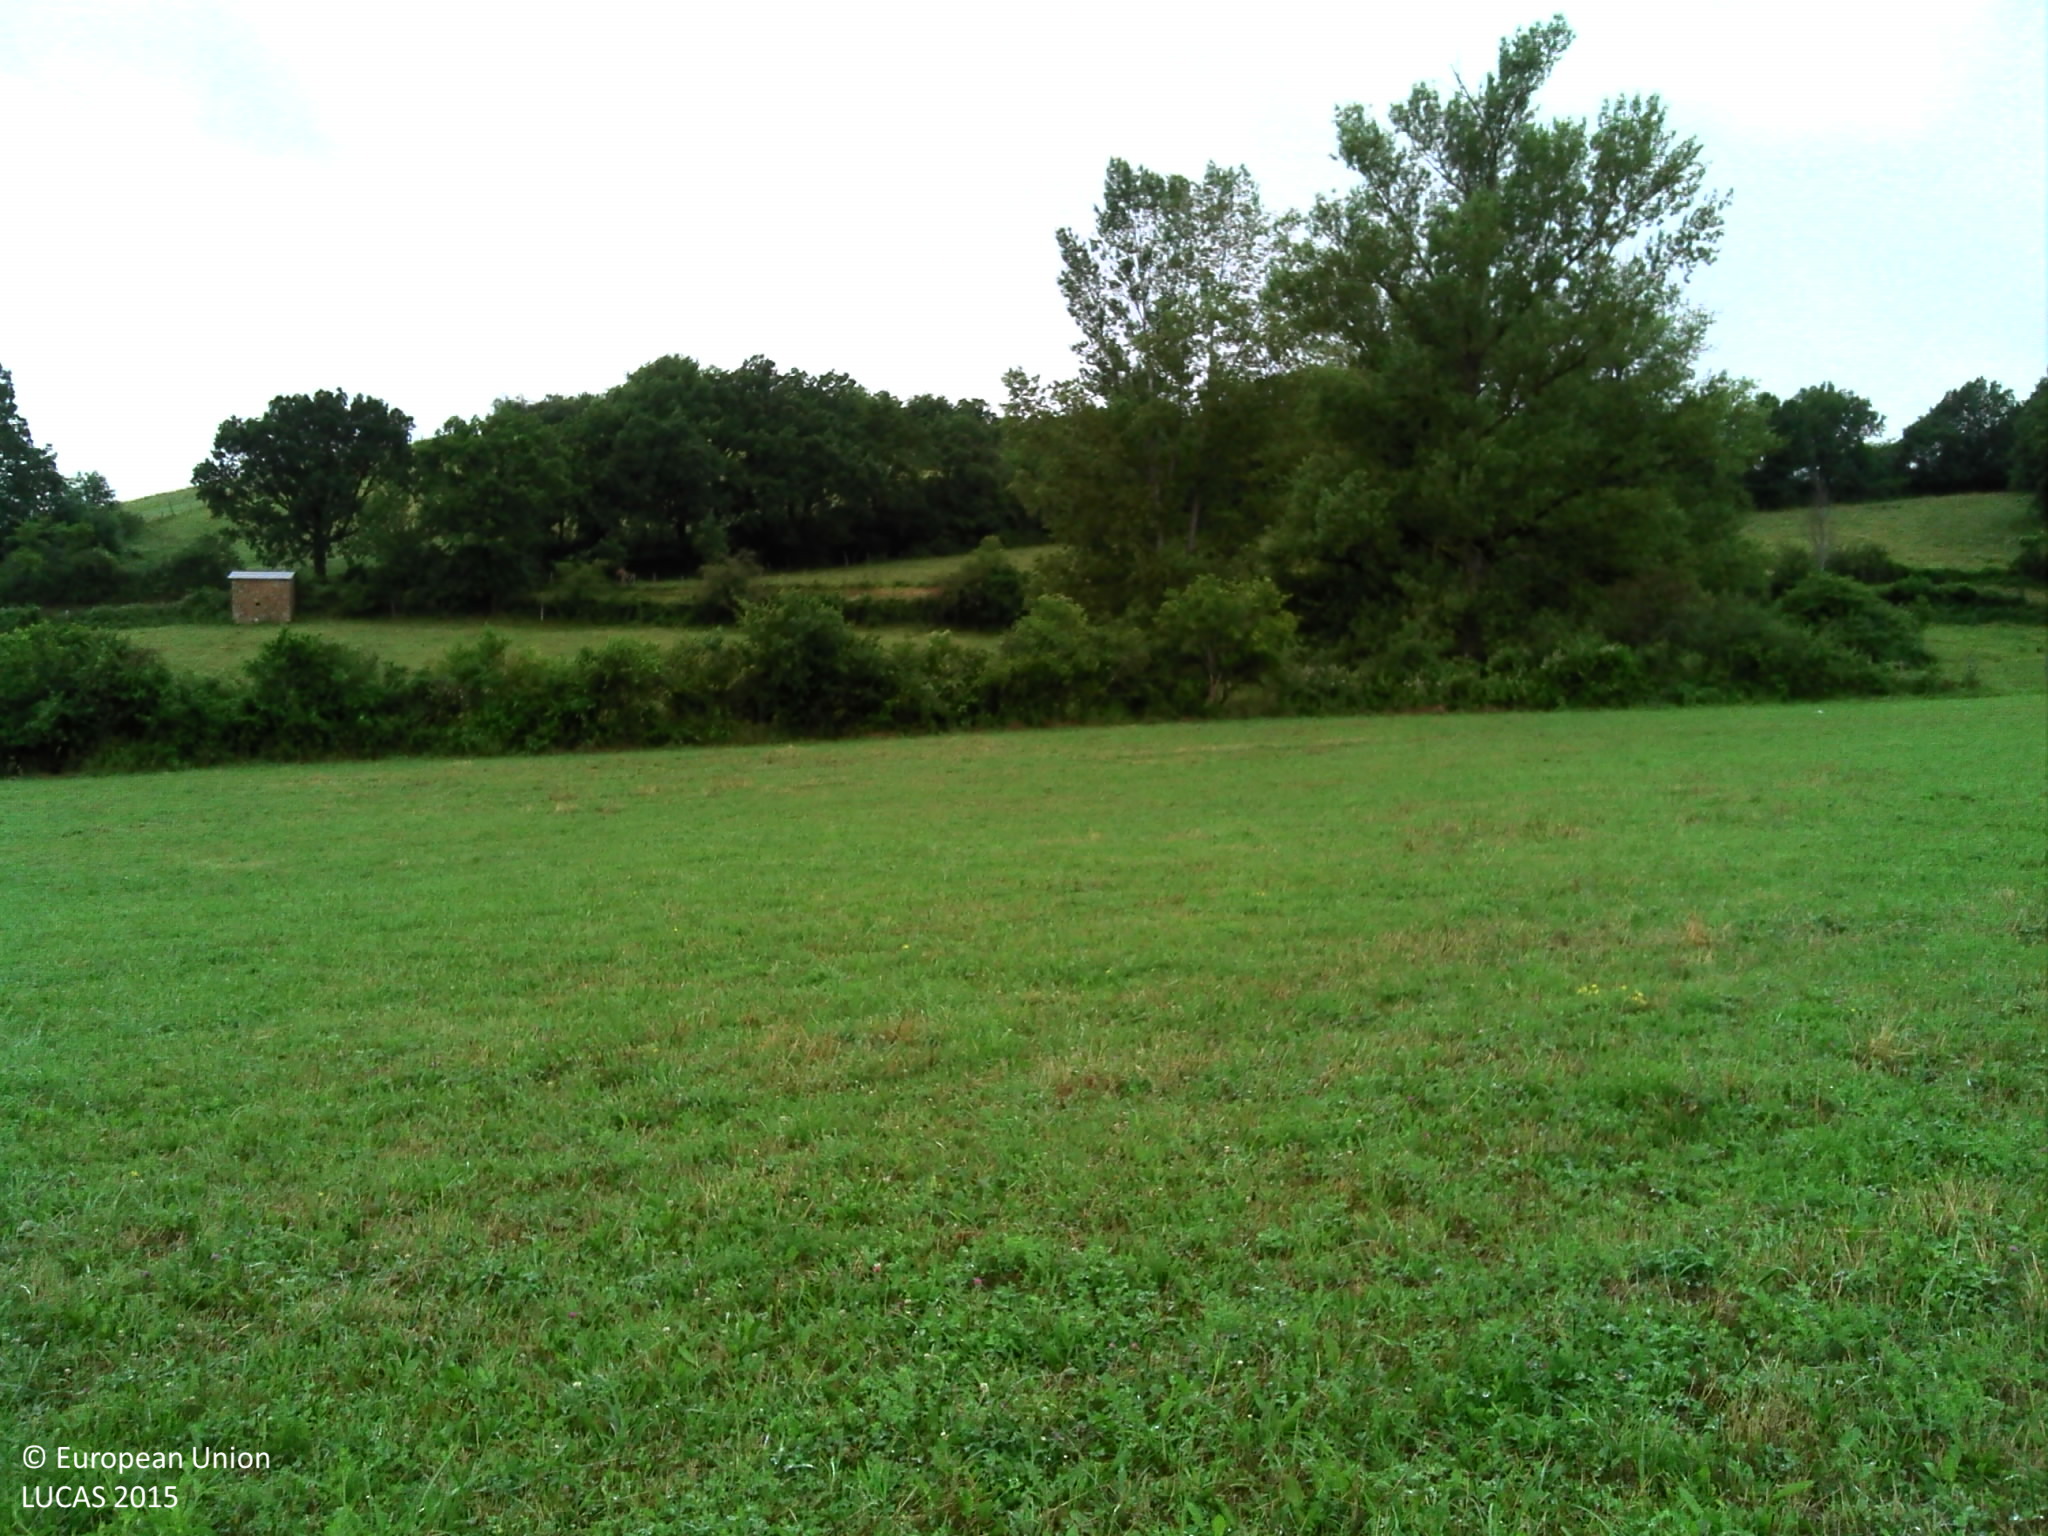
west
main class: Grassland
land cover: Grassland without tree/shrub cover
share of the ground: > 75 %
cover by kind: herbaceous plants 100 %
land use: Agriculture (excluding fallow land and kitchen gardens)
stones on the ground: 10 - 25 %
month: June
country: FR
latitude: 44.3700
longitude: 2.0326
